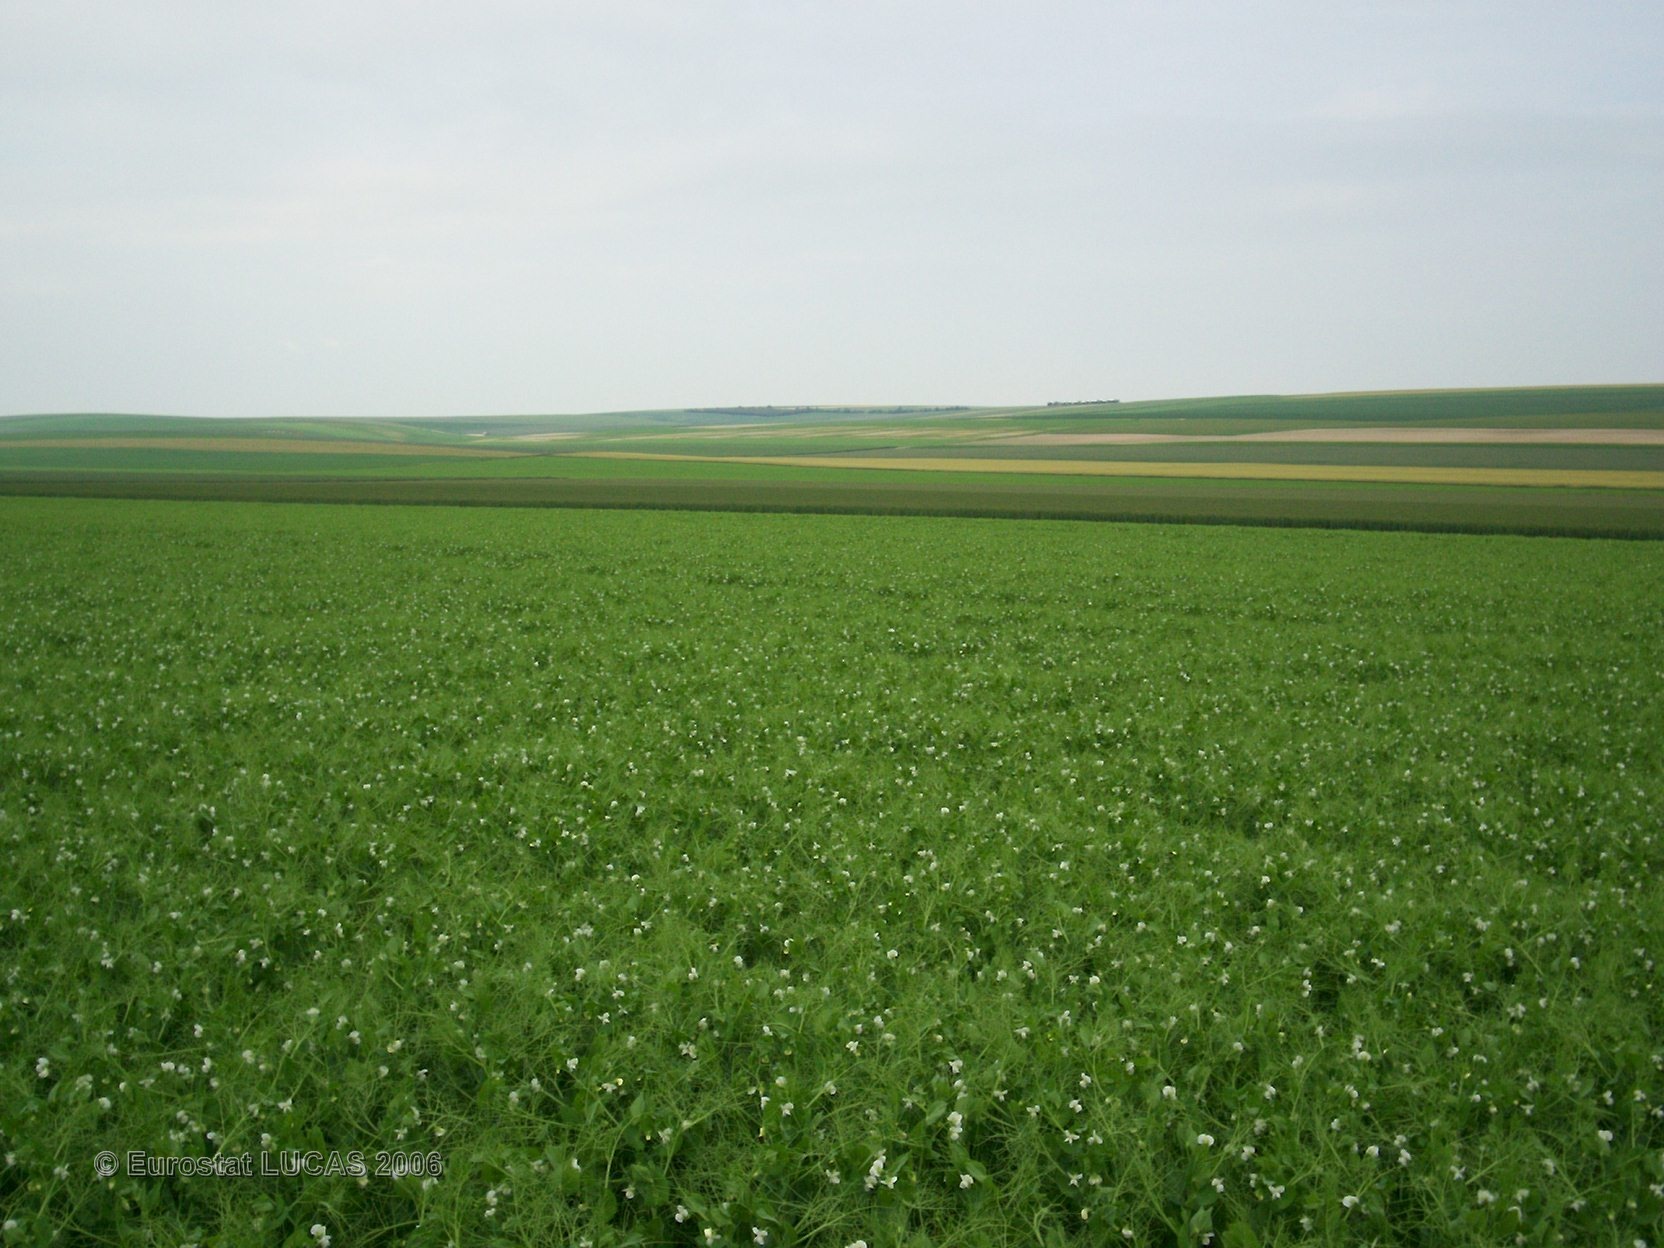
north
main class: Cropland
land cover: Dry pulses
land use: Agriculture (excluding fallow land and kitchen gardens)
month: June
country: FR
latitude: 48.7337
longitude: 4.4631
